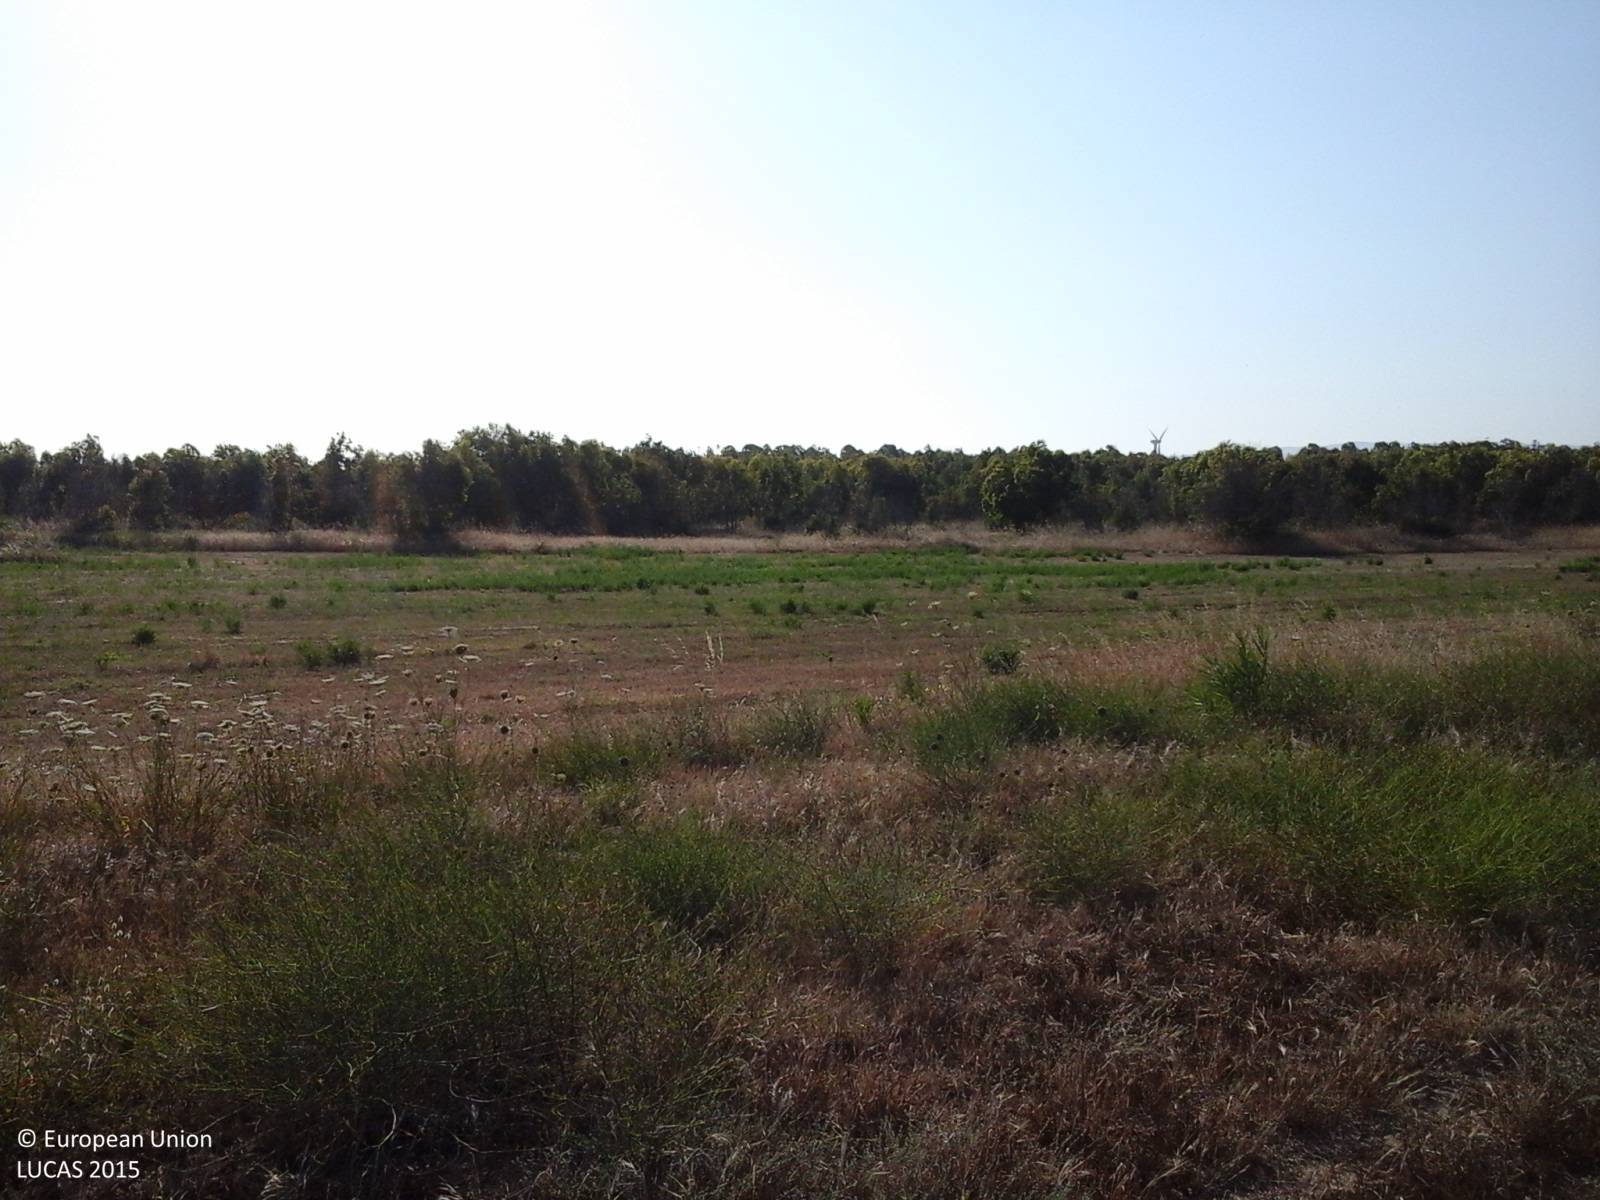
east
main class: Grassland
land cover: Grassland without tree/shrub cover
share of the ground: > 75 %
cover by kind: herbaceous plants 100 %
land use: Agriculture (excluding fallow land and kitchen gardens)
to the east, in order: Grassland without tree/shrub cover; Broadleaved woodland; Tracks; Broadleaved woodland
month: June
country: IT
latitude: 39.8763
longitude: 8.5466
